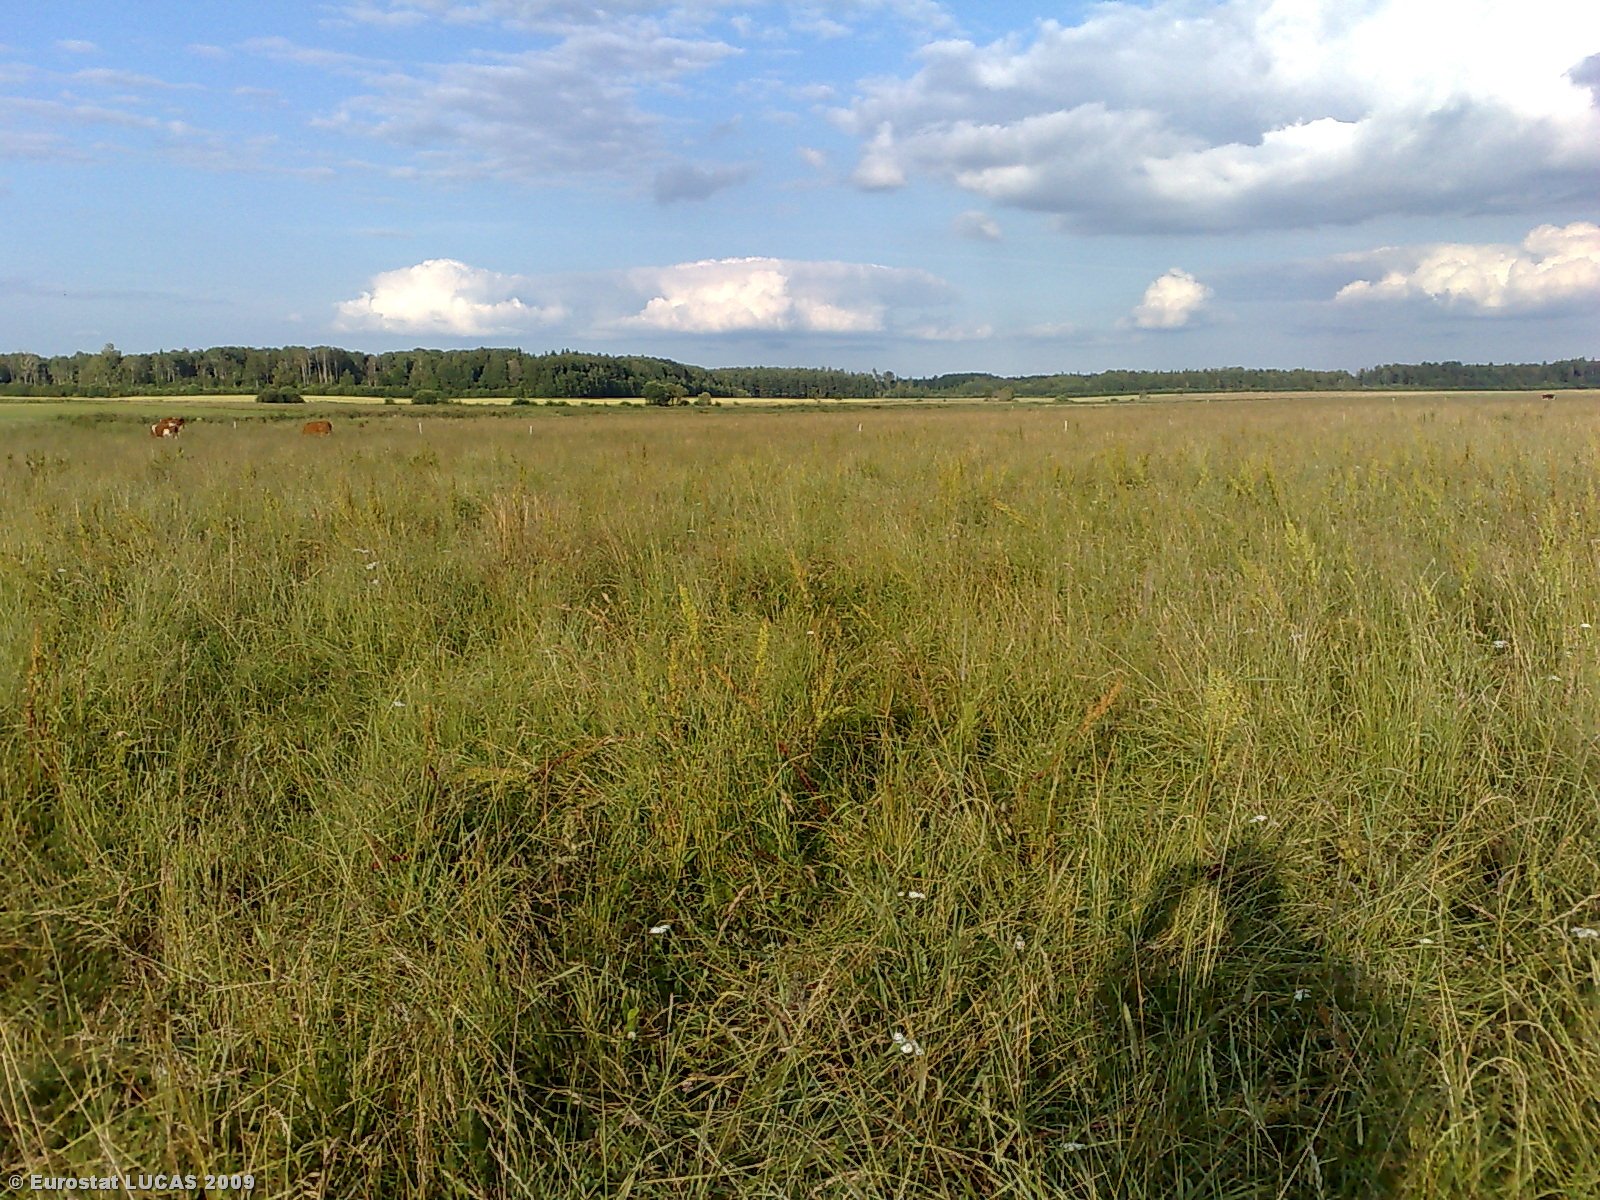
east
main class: Grassland
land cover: Grassland without tree/shrub cover
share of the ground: > 75 %
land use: Agriculture (excluding fallow land and kitchen gardens)
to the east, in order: Grassland without tree/shrub cover; Fences; Grassland without tree/shrub cover
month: July
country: LT
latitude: 55.7767
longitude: 22.8360
